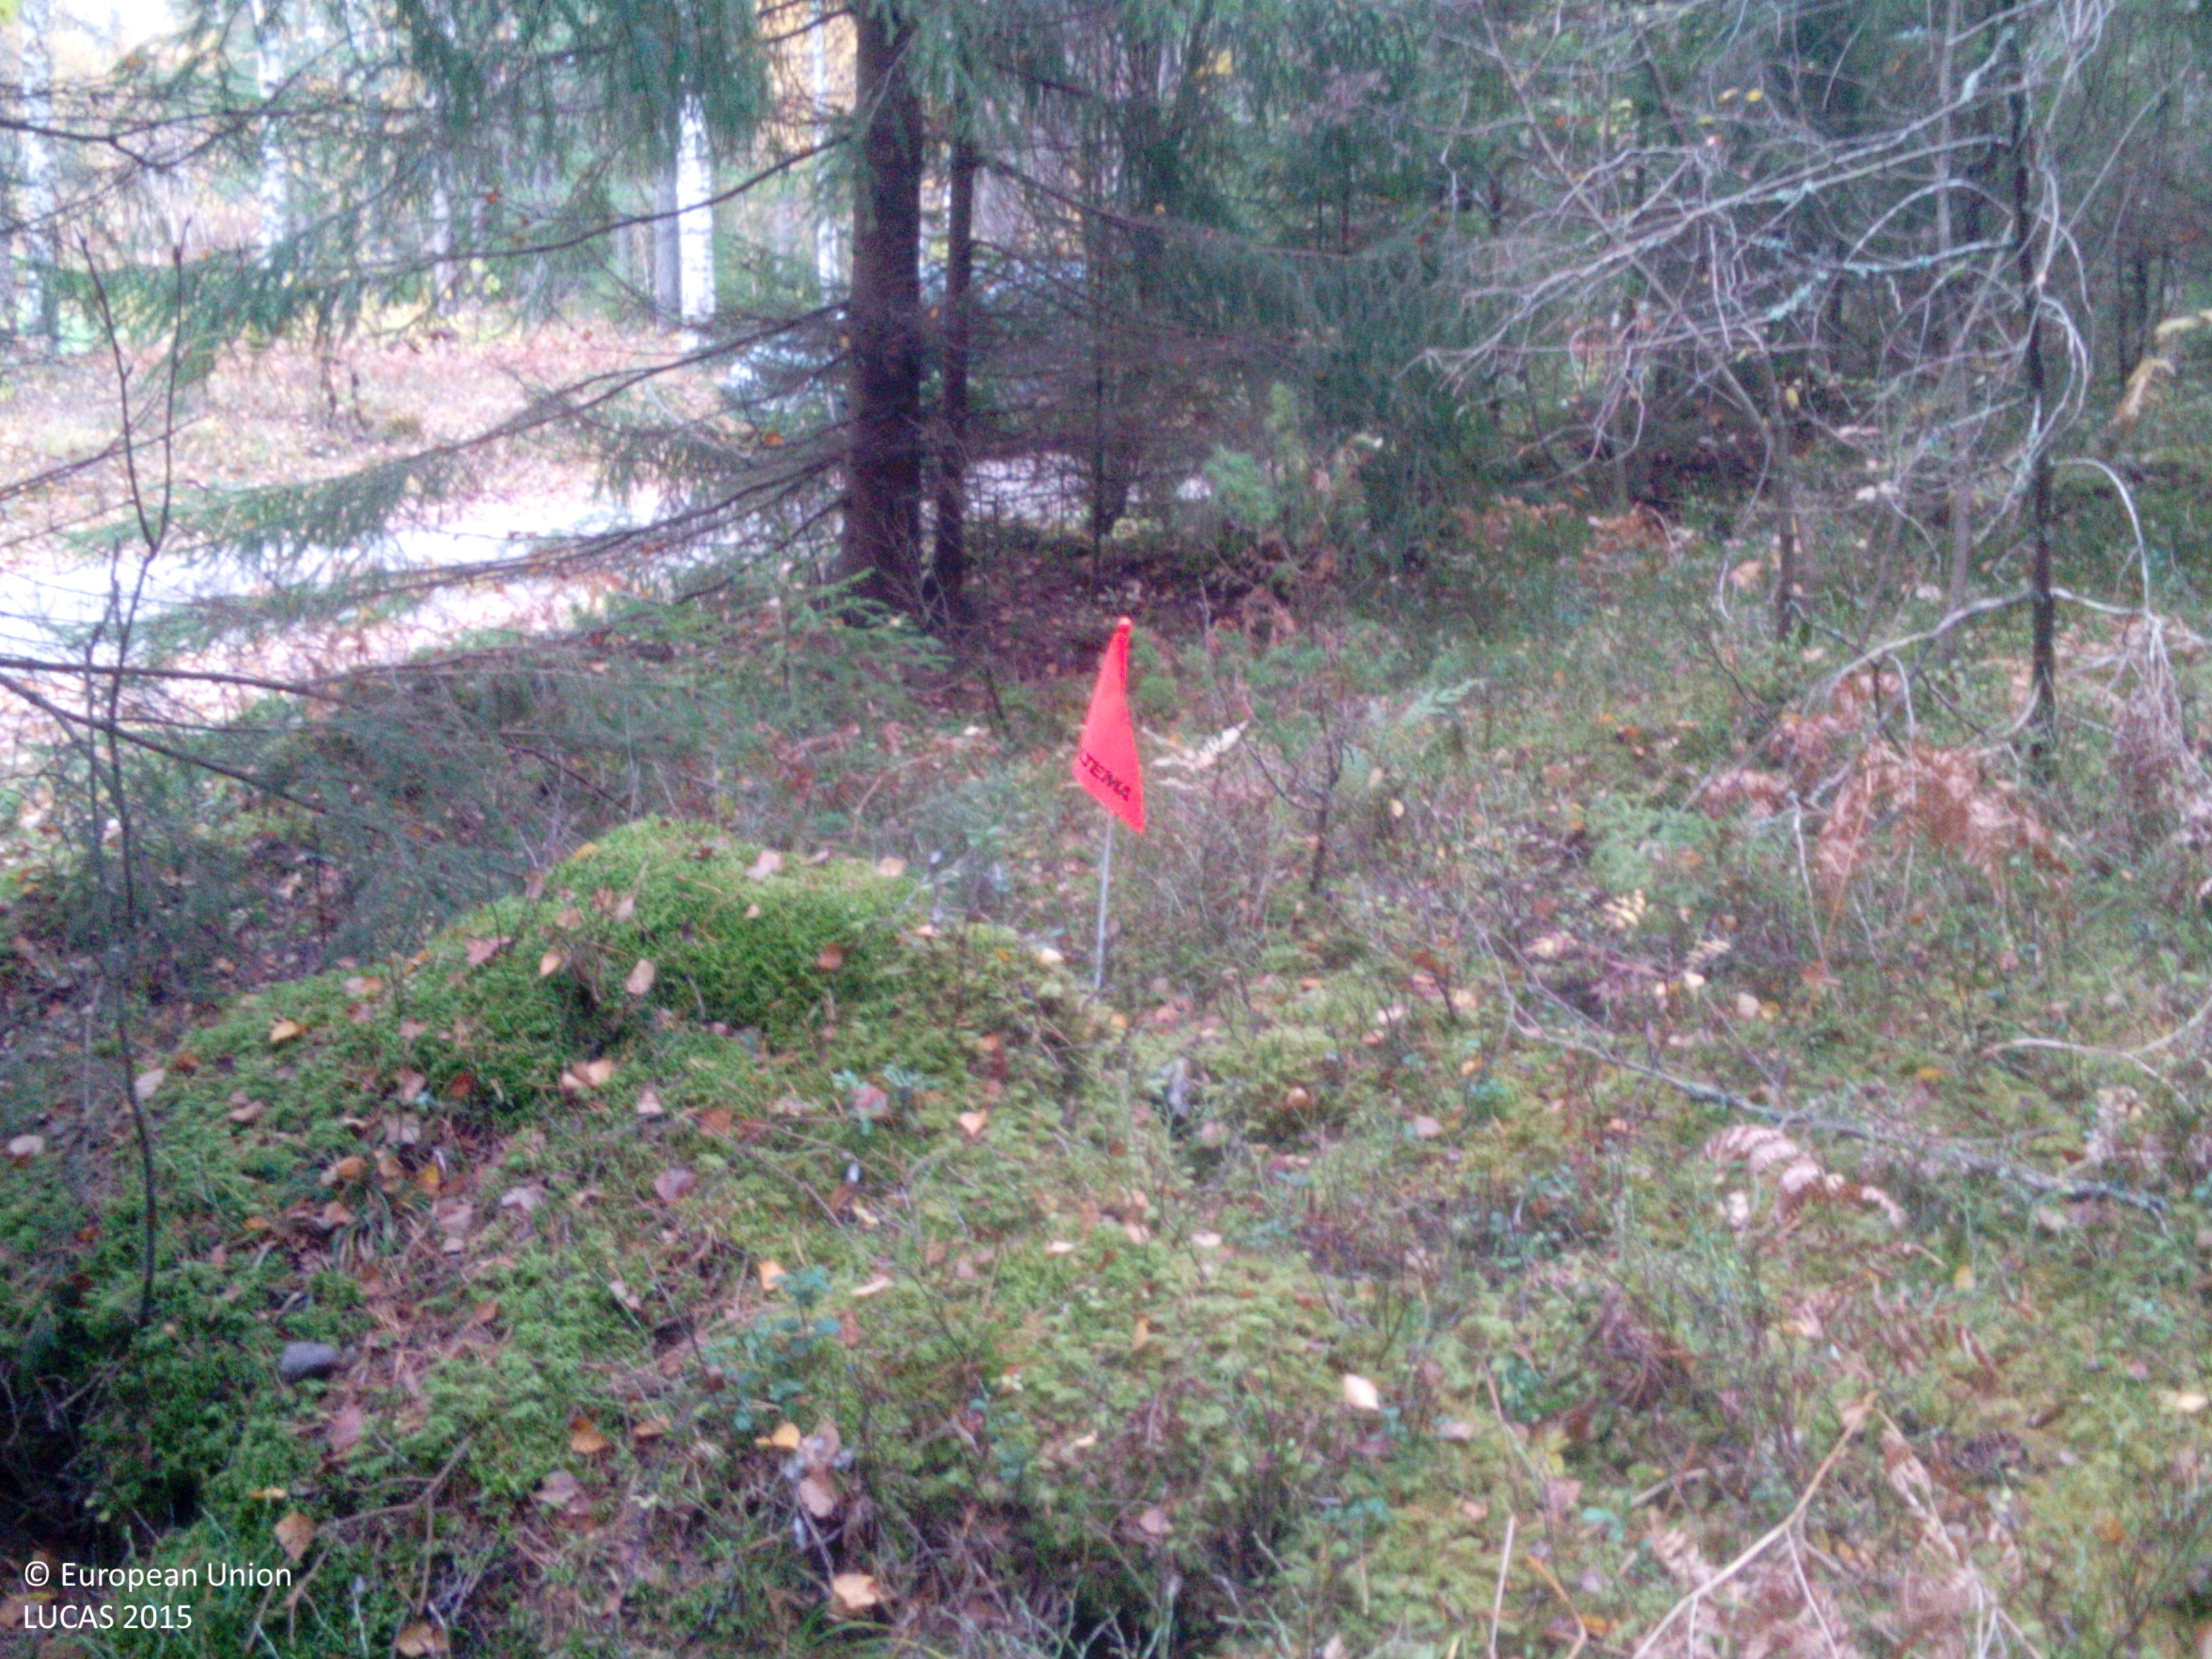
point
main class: Woodland
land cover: Spruce dominated coniferous woodland
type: boreal forest
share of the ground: > 75 %
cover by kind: coniferous forest trees 85 %, herbaceous plants 5 %, lichens and mosses 5 %, consolidated bare surface 5 %
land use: Forestry
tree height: > 5 m
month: October
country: SE
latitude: 59.0488
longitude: 16.2518
